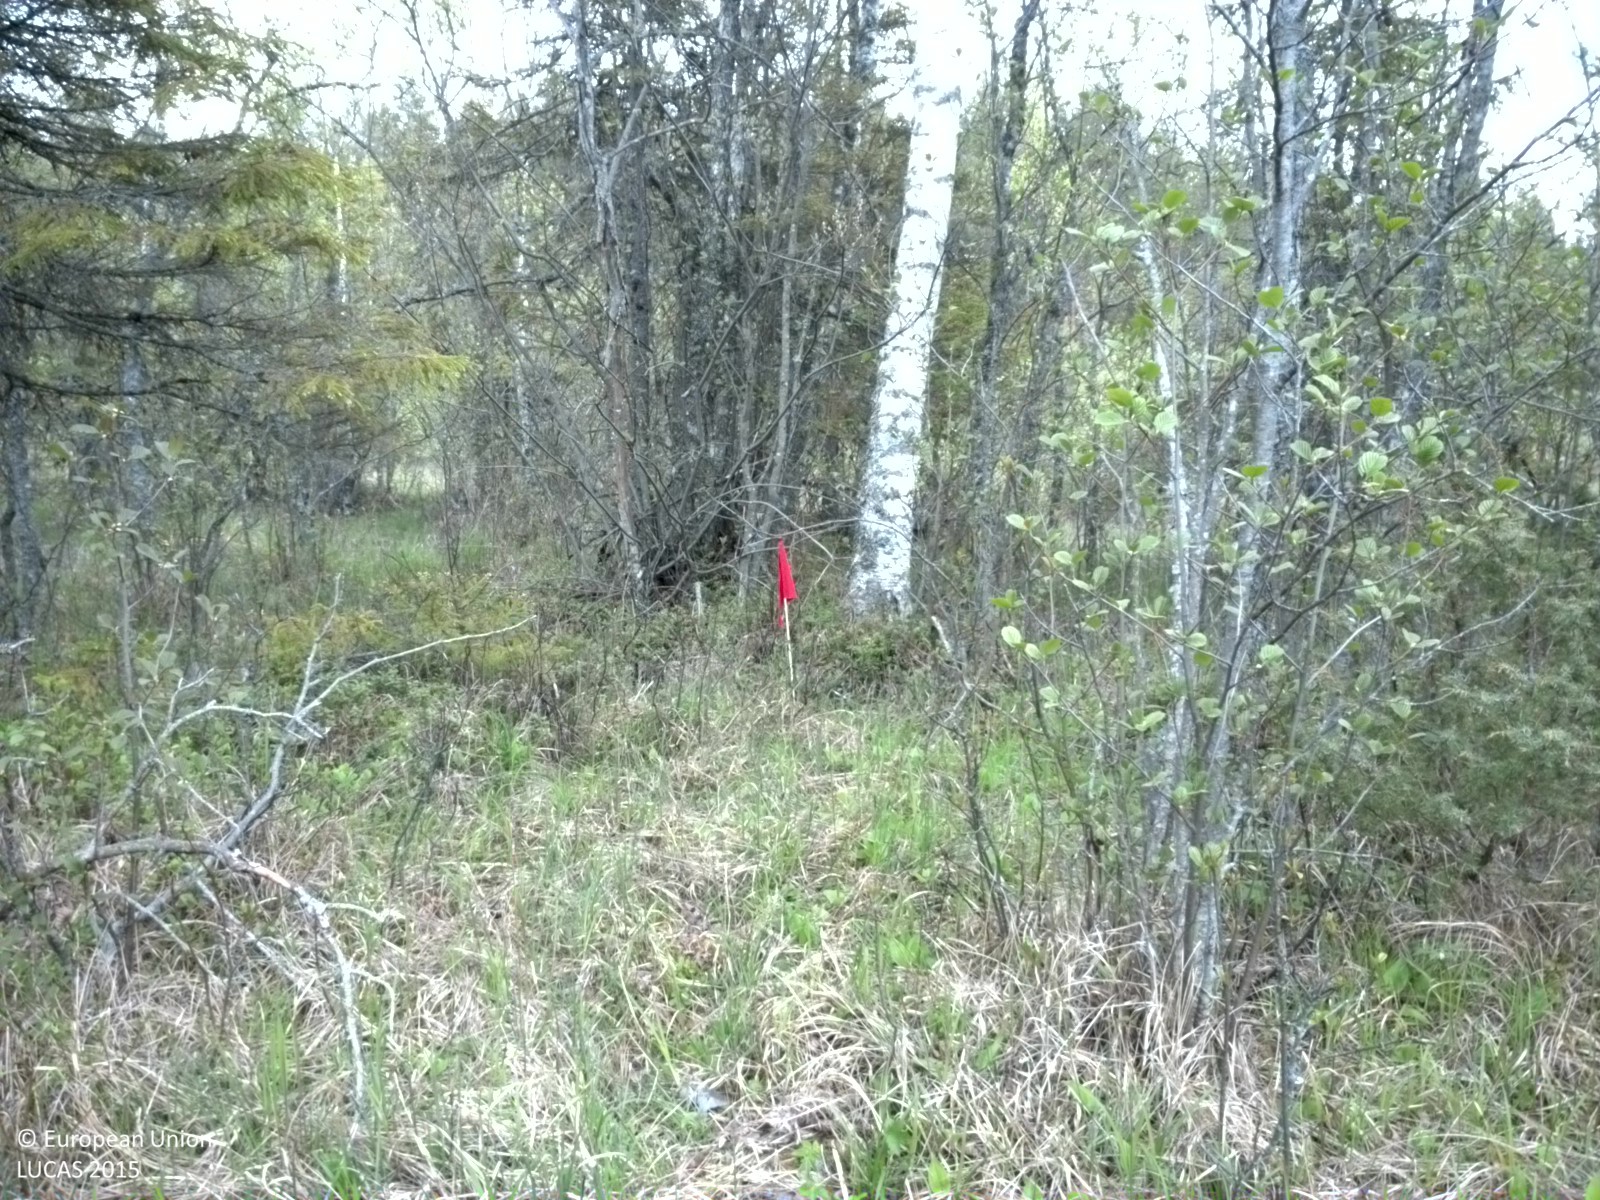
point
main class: Woodland
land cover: Spruce dominated mixed woodland
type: boreal forest
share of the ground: > 75 %
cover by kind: coniferous forest trees 40 %, broadleaved forest trees 40 %, herbaceous plants 15 %, shrubs 5 %
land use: Forestry
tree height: > 5 m
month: May
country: SE
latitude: 60.2928
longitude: 18.0804
